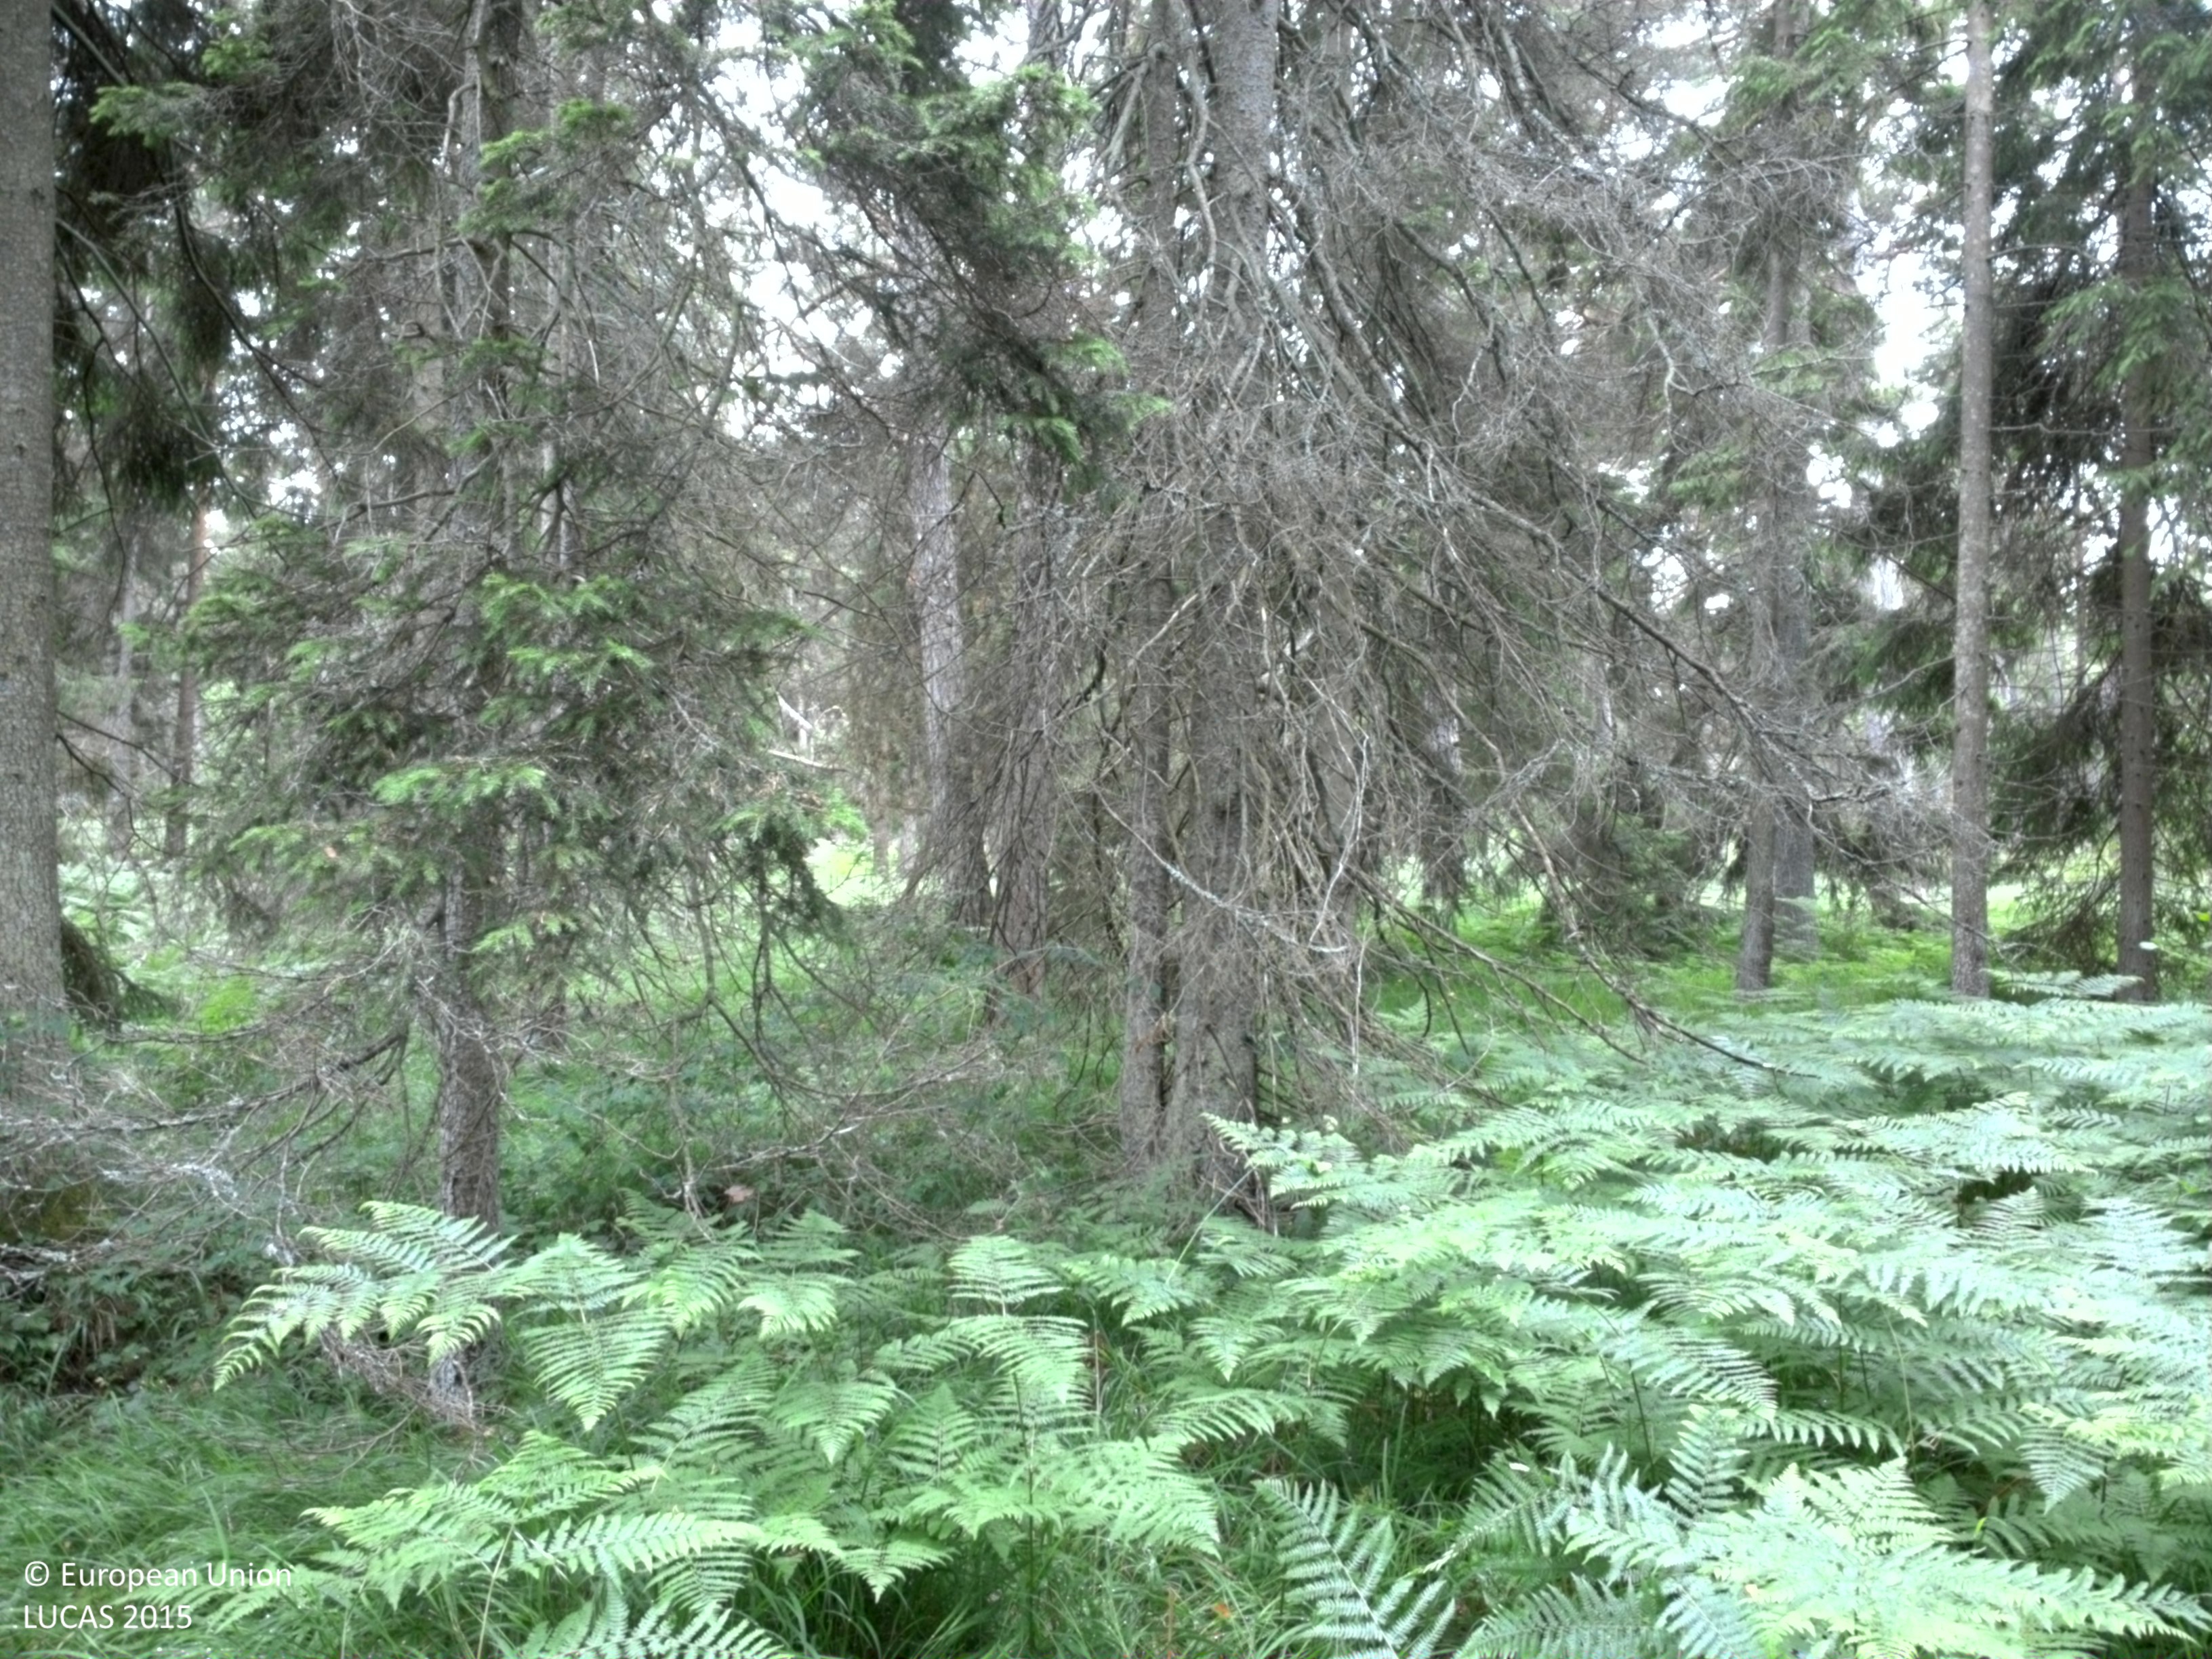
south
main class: Woodland
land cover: Spruce dominated coniferous woodland
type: hemiboreal forest and nemoral coniferous forest and mixed broadleaved-coniferous forest
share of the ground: 50 - 75 %
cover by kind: coniferous forest trees 65 %, herbaceous plants 30 %, shrubs 5 %
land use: Community services
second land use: Forestry
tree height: > 5 m
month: July
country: SE
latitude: 57.5540
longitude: 18.1786
